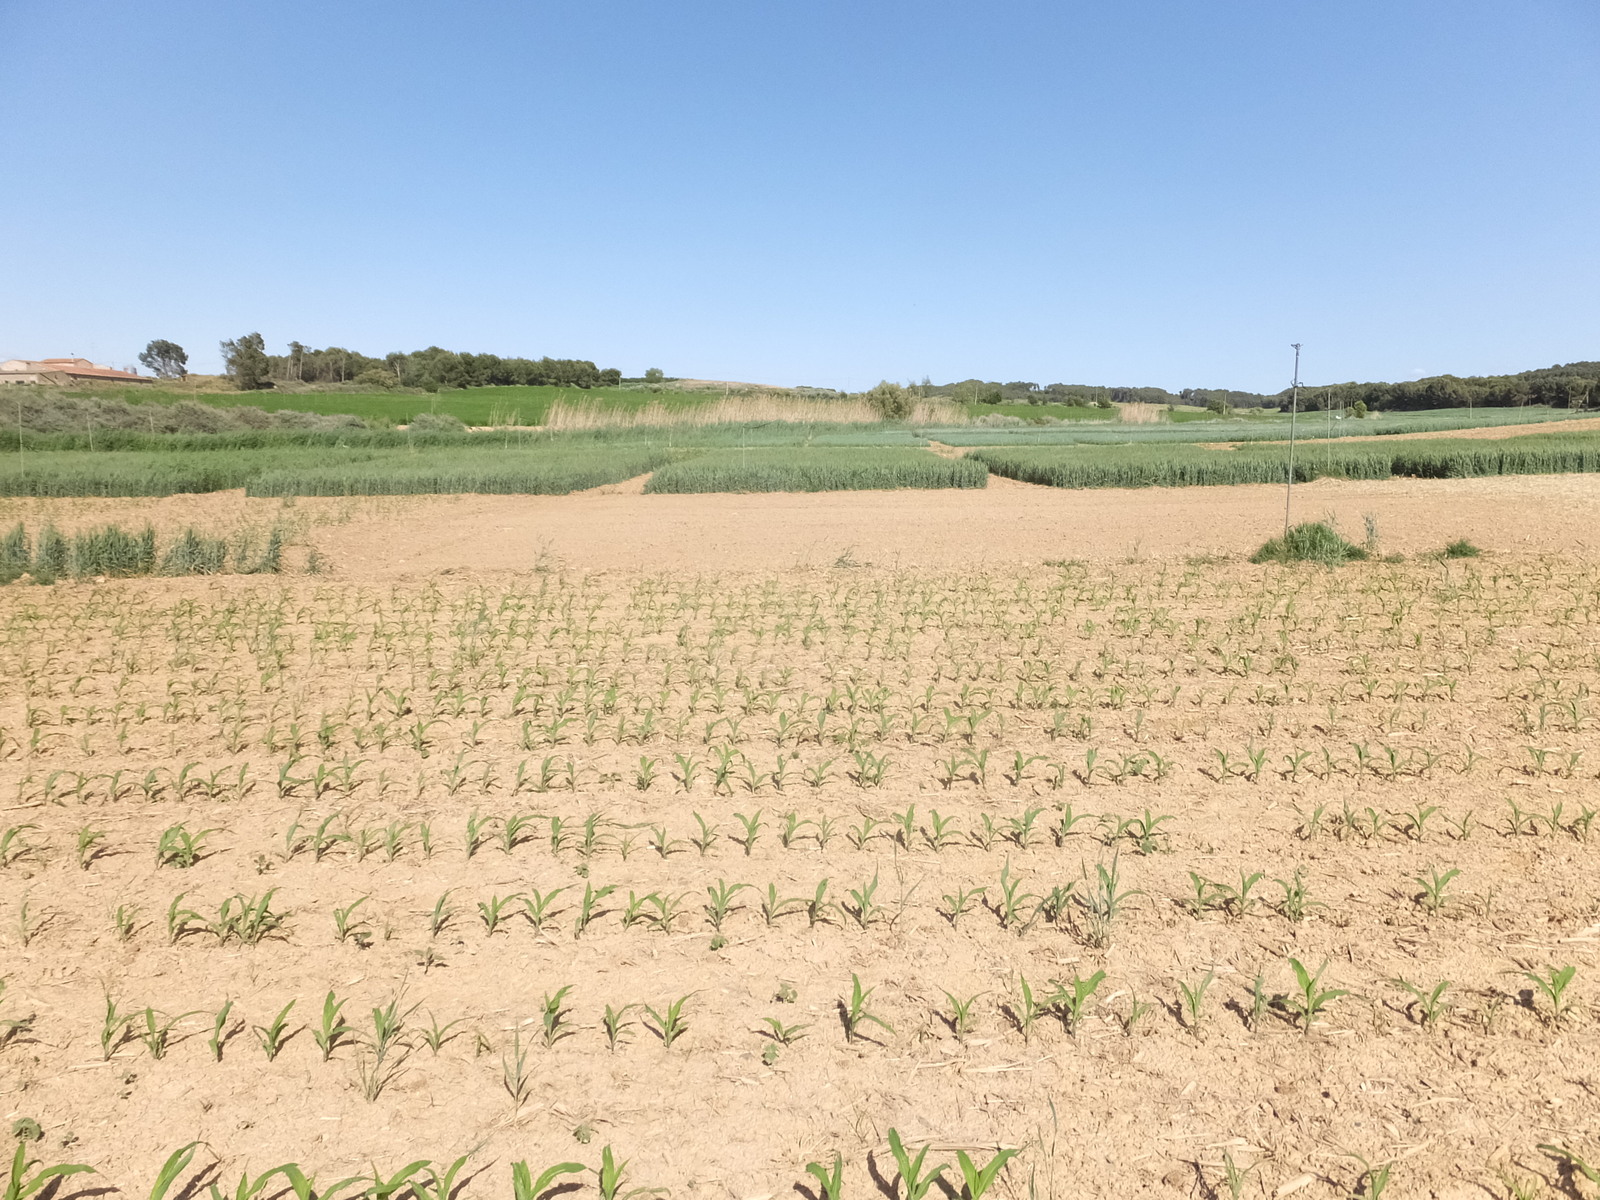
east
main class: Cropland
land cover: Maize
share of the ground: 10 - 25 %
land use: Agriculture (excluding fallow land and kitchen gardens)
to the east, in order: Maize; Other bare soil; Durum wheat; Barley; Other bare soil; Ditches and canals; Shruby margins; Lucerne
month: May
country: ES
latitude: 41.6642
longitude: 0.3420
